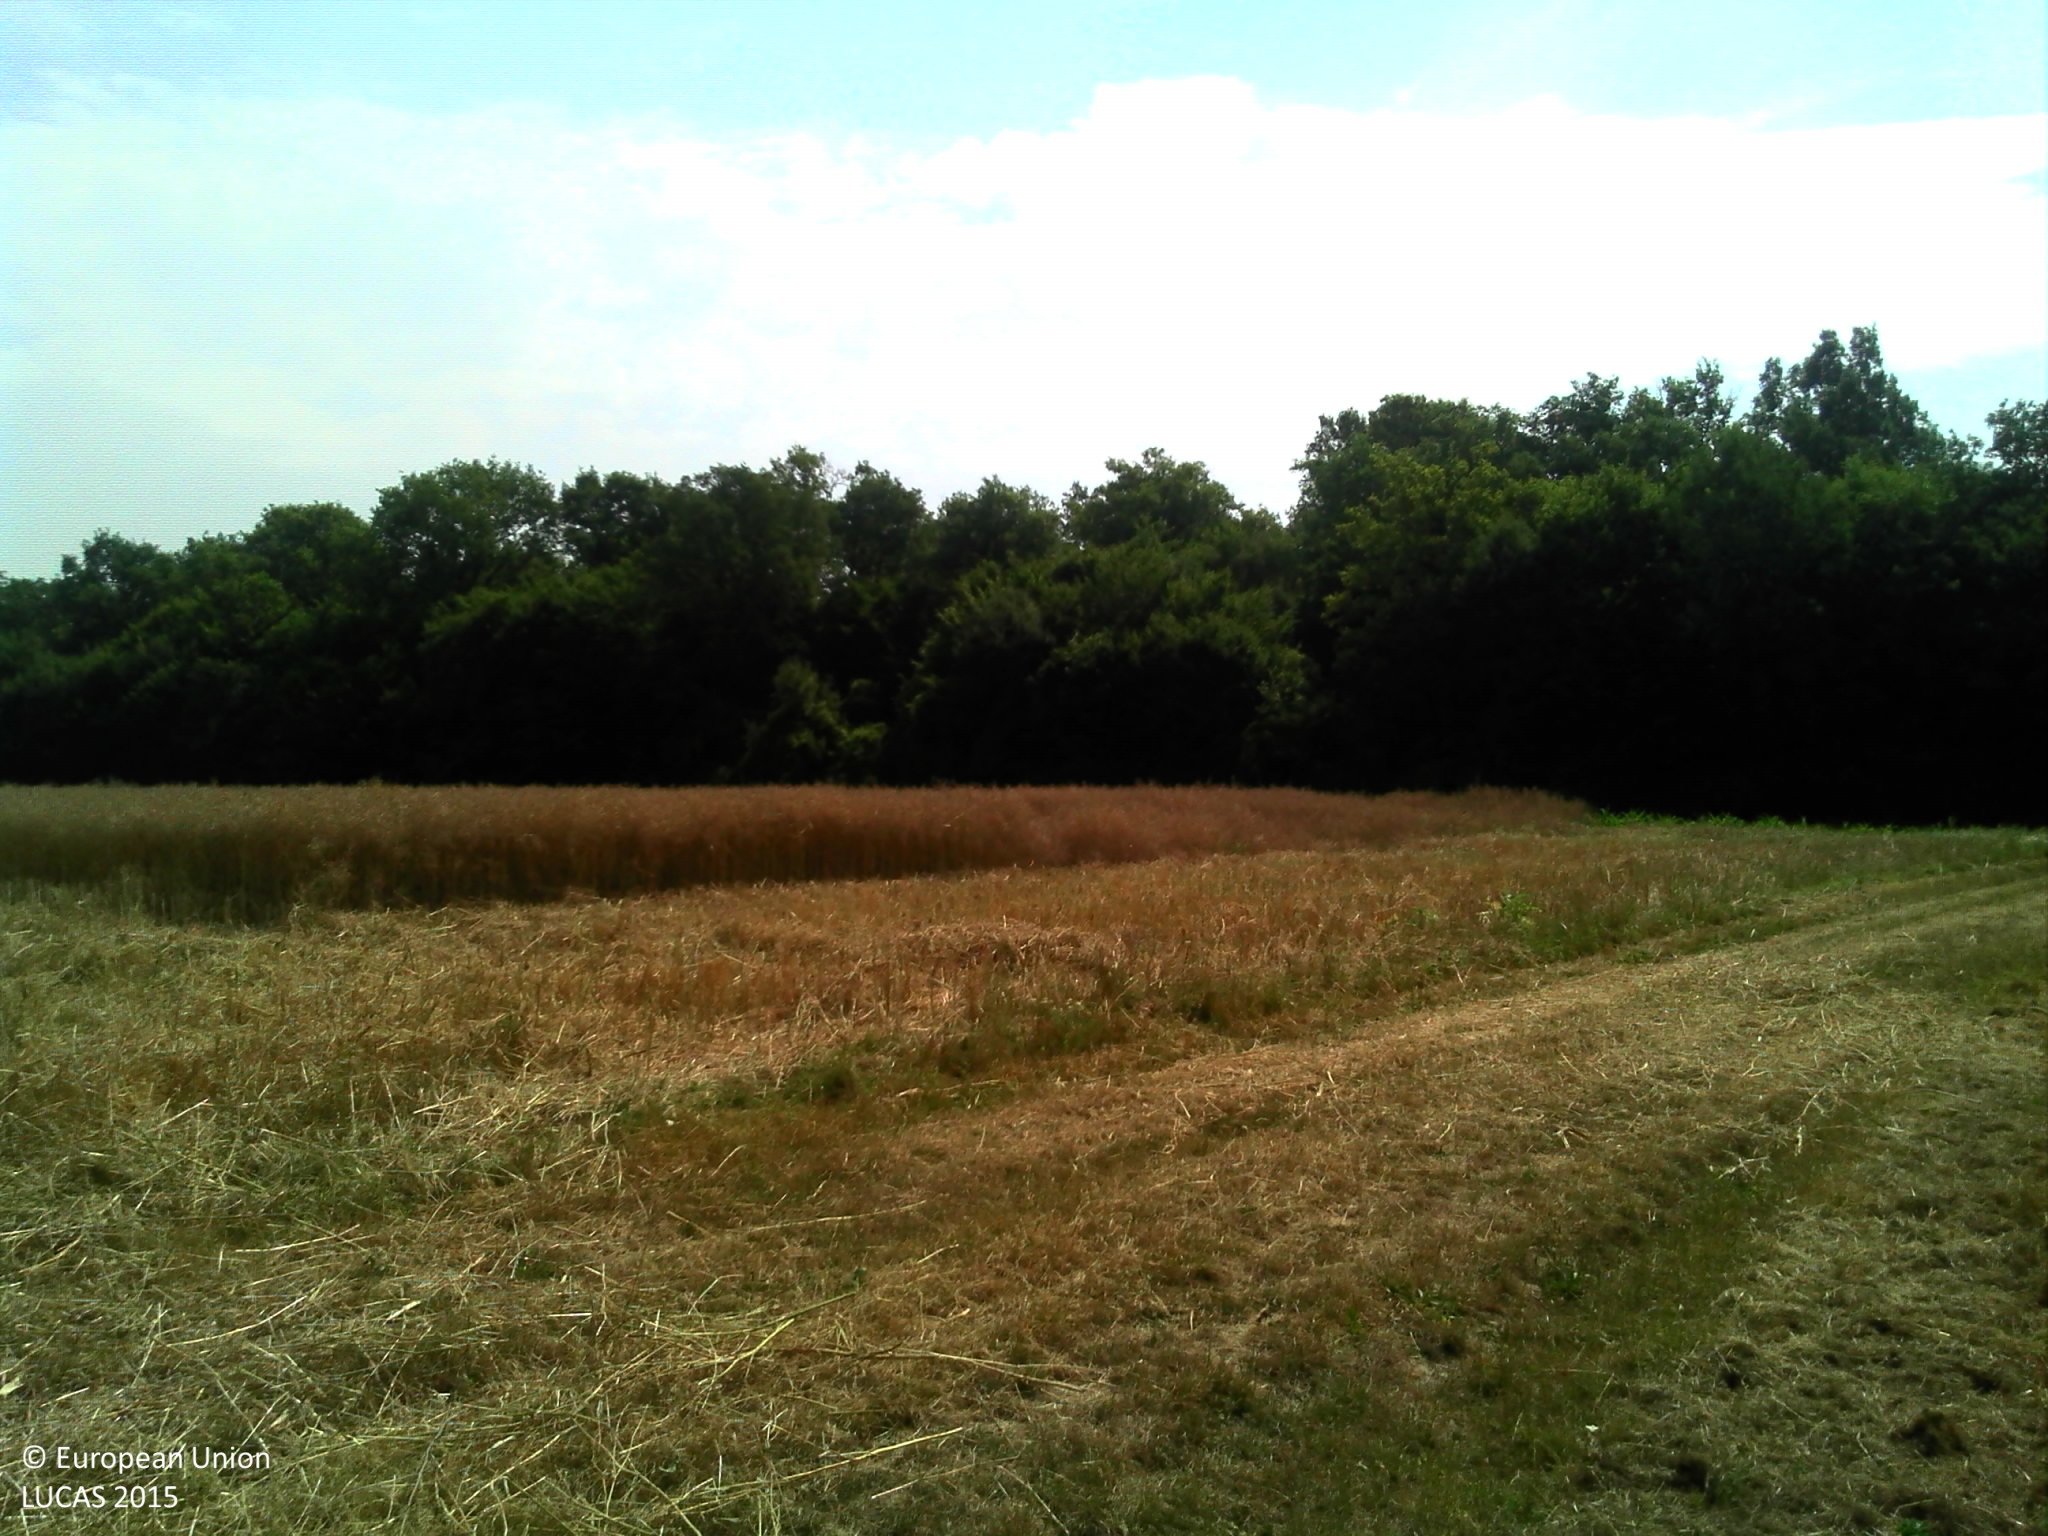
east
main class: Cropland
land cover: Rape and turnip rape
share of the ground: > 75 %
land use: Agriculture (excluding fallow land and kitchen gardens)
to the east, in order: Grass margins; Tracks; Rape and turnip rape; Maize; Broadleaved woodland; Tracks; Broadleaved woodland
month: July
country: FR
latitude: 47.8249
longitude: 2.7927
